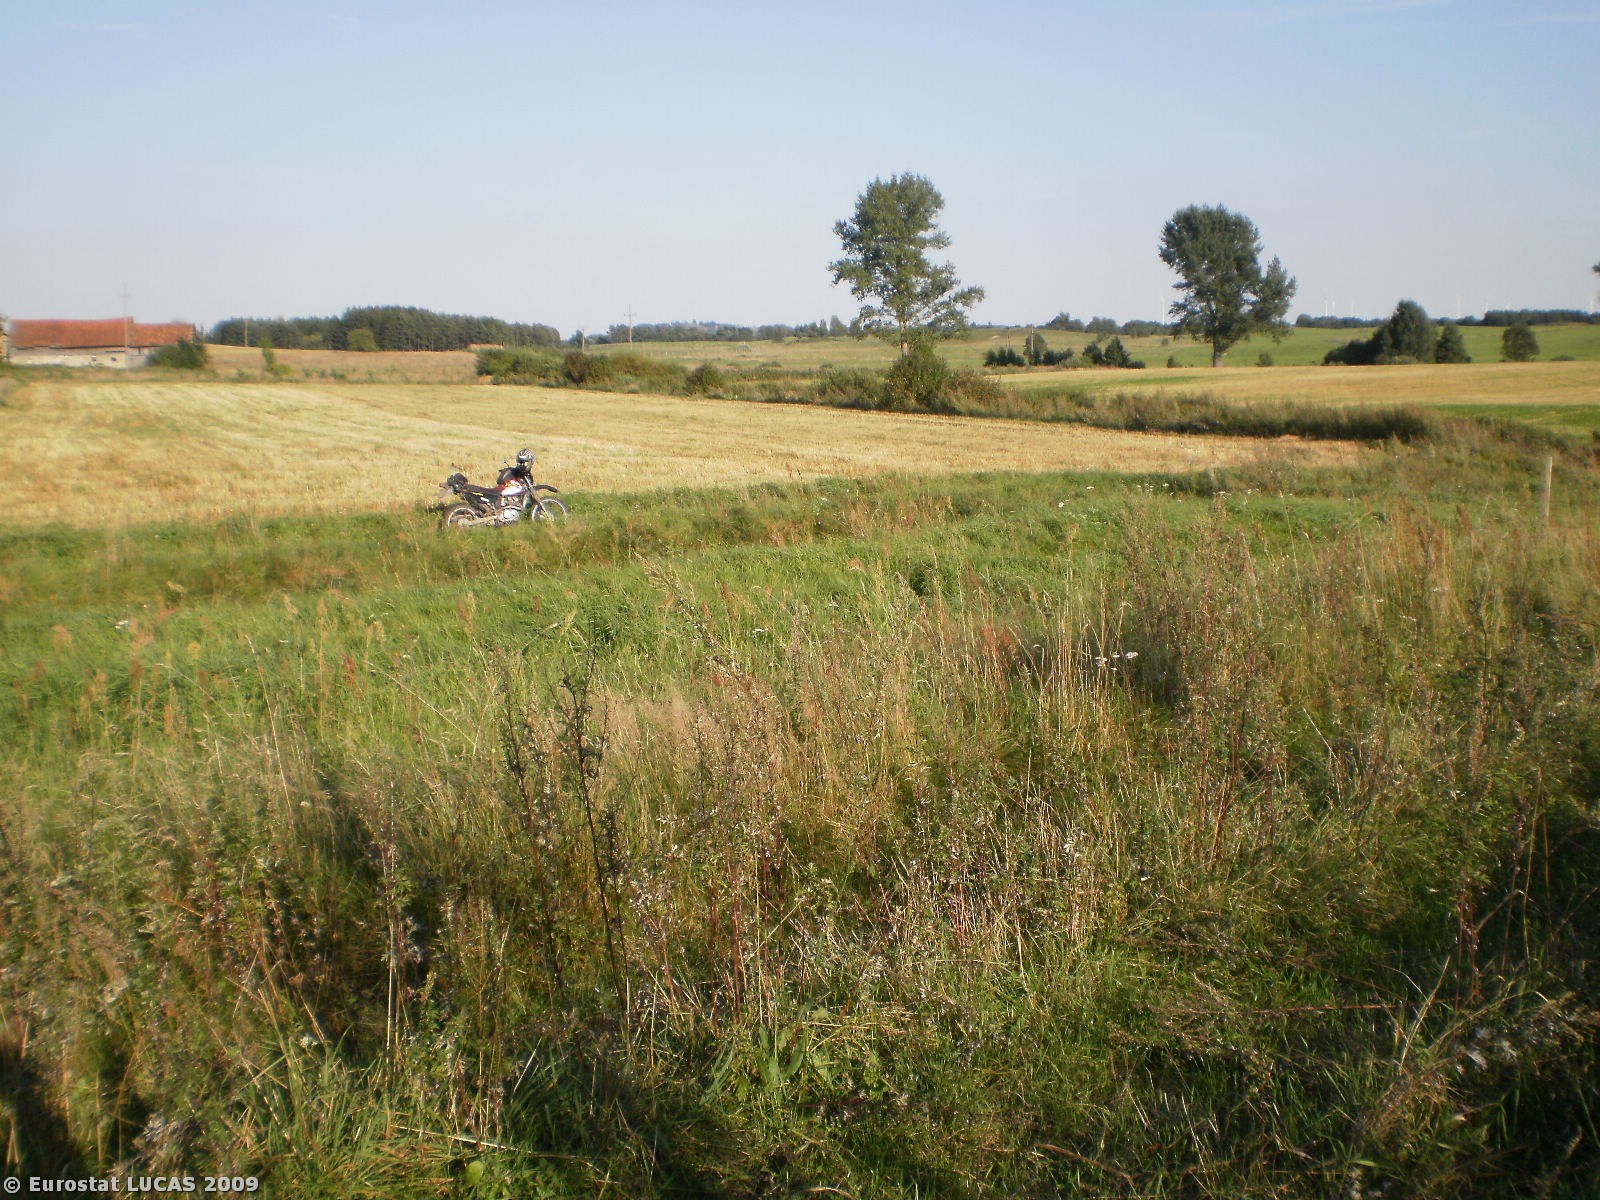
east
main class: Grassland
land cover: Grassland without tree/shrub cover
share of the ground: > 75 %
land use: Agriculture (excluding fallow land and kitchen gardens)
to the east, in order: Grassland without tree/shrub cover; Fences; Grass margins; Tracks; Grassland without tree/shrub cover; Ditches and canals; Grass margins; Oats; Grassland with sparse tree/shrub cover; Grassland without tree/shrub cover; Electric lines; Grassland without tree/shrub cover
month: August
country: PL
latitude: 54.2913
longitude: 22.2118
